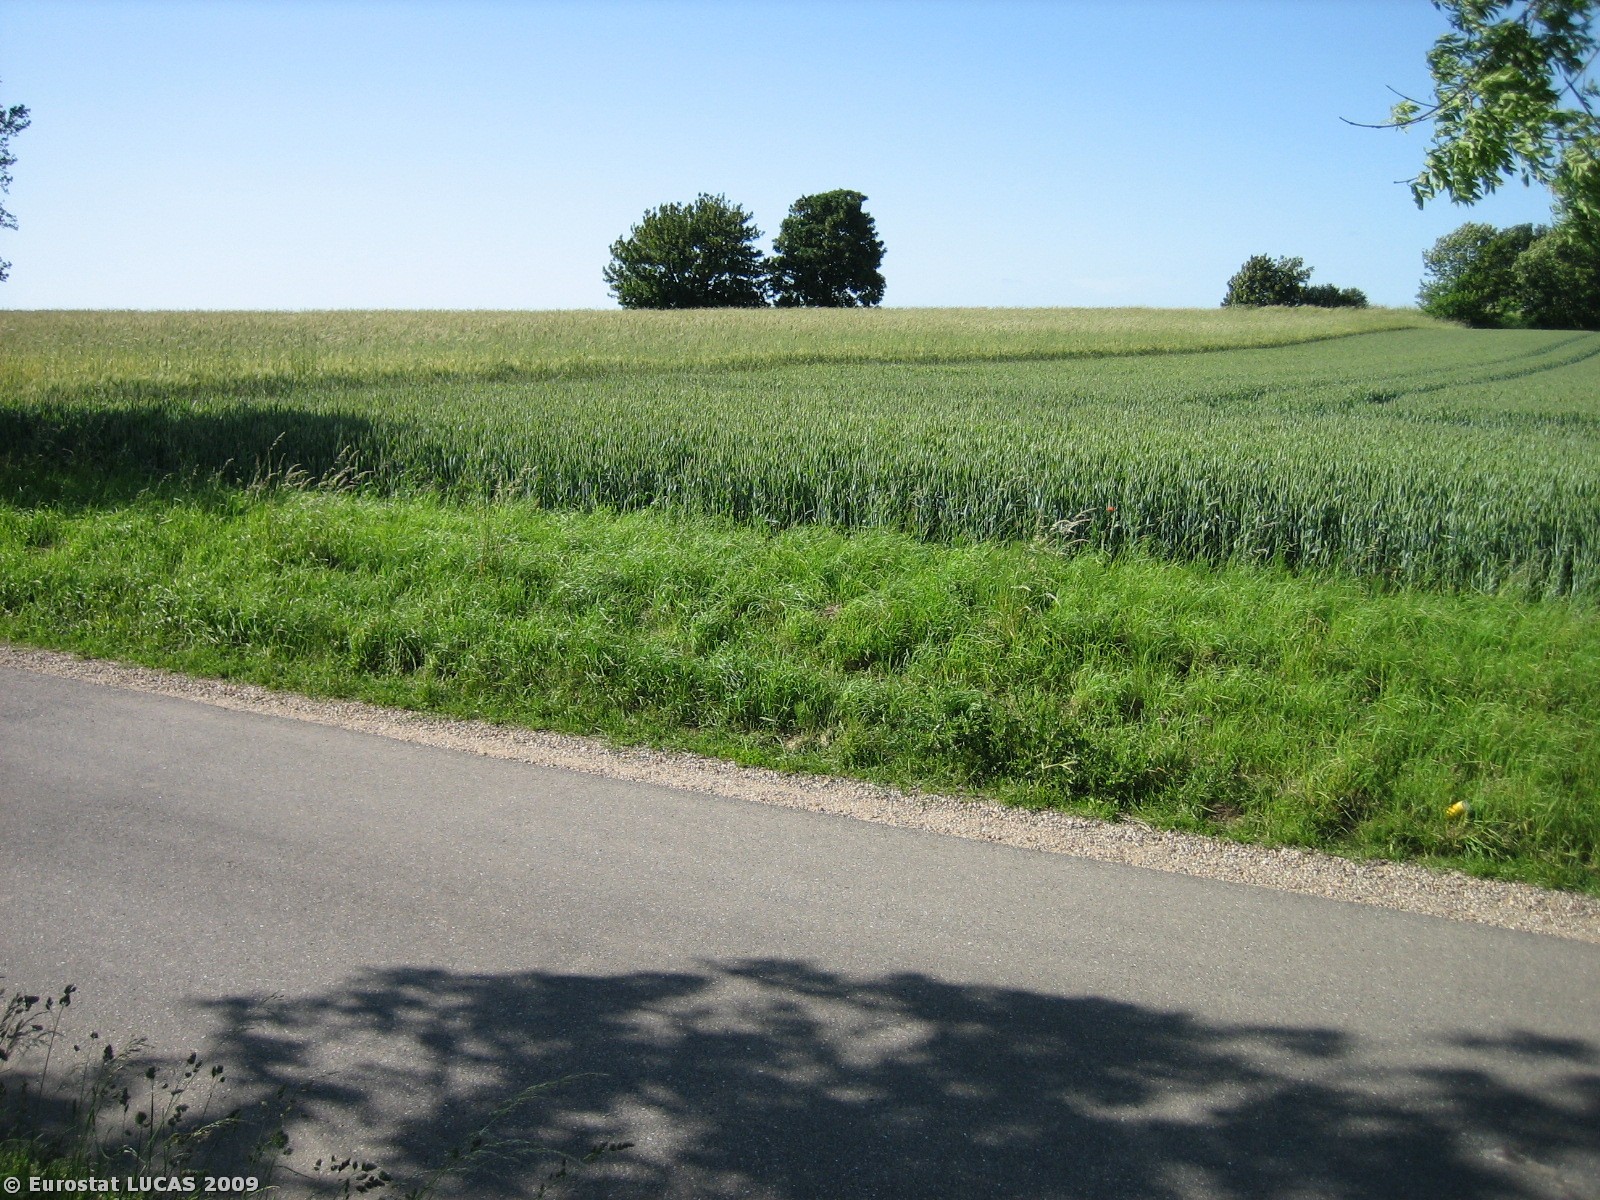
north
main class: Cropland
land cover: Common wheat
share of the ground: > 75 %
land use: Agriculture (excluding fallow land and kitchen gardens)
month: June
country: DK
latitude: 55.8821
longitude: 9.8563
